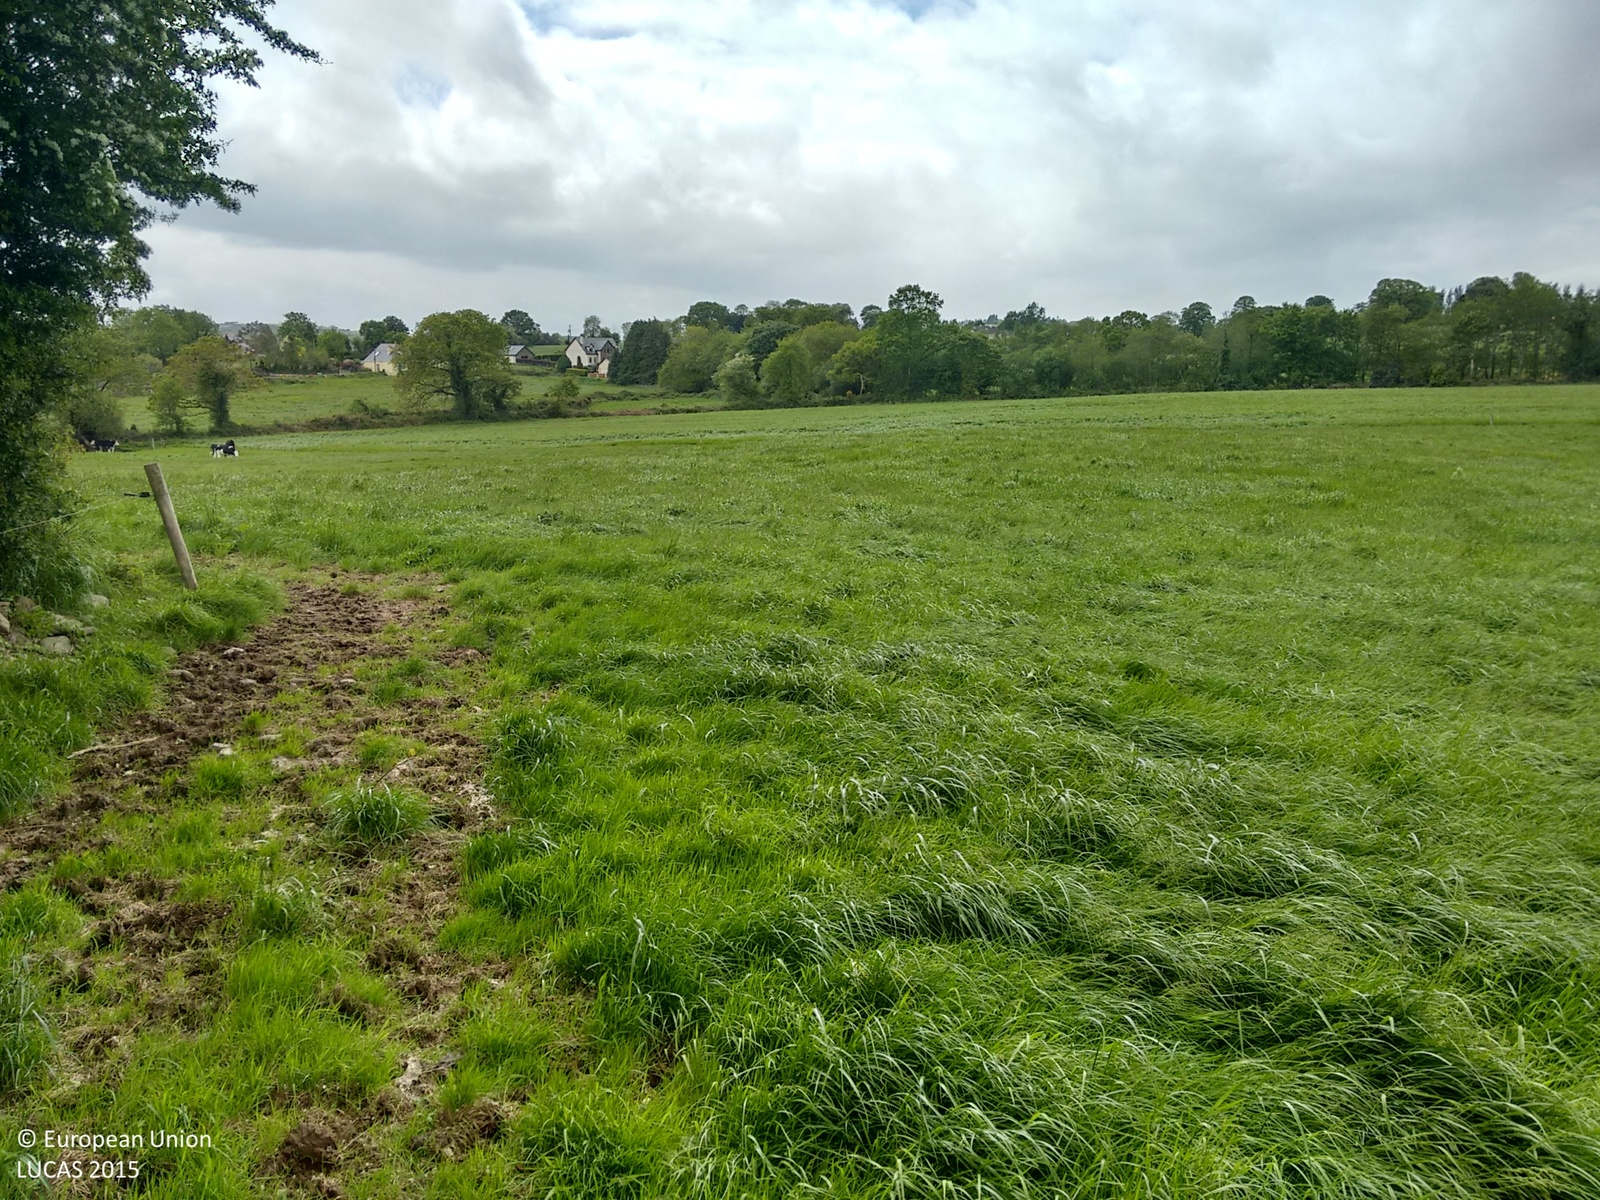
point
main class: Grassland
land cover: Grassland without tree/shrub cover
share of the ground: > 75 %
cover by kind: herbaceous plants 100 %
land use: Agriculture (excluding fallow land and kitchen gardens)
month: June
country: IE
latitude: 51.9093
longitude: -8.7972
